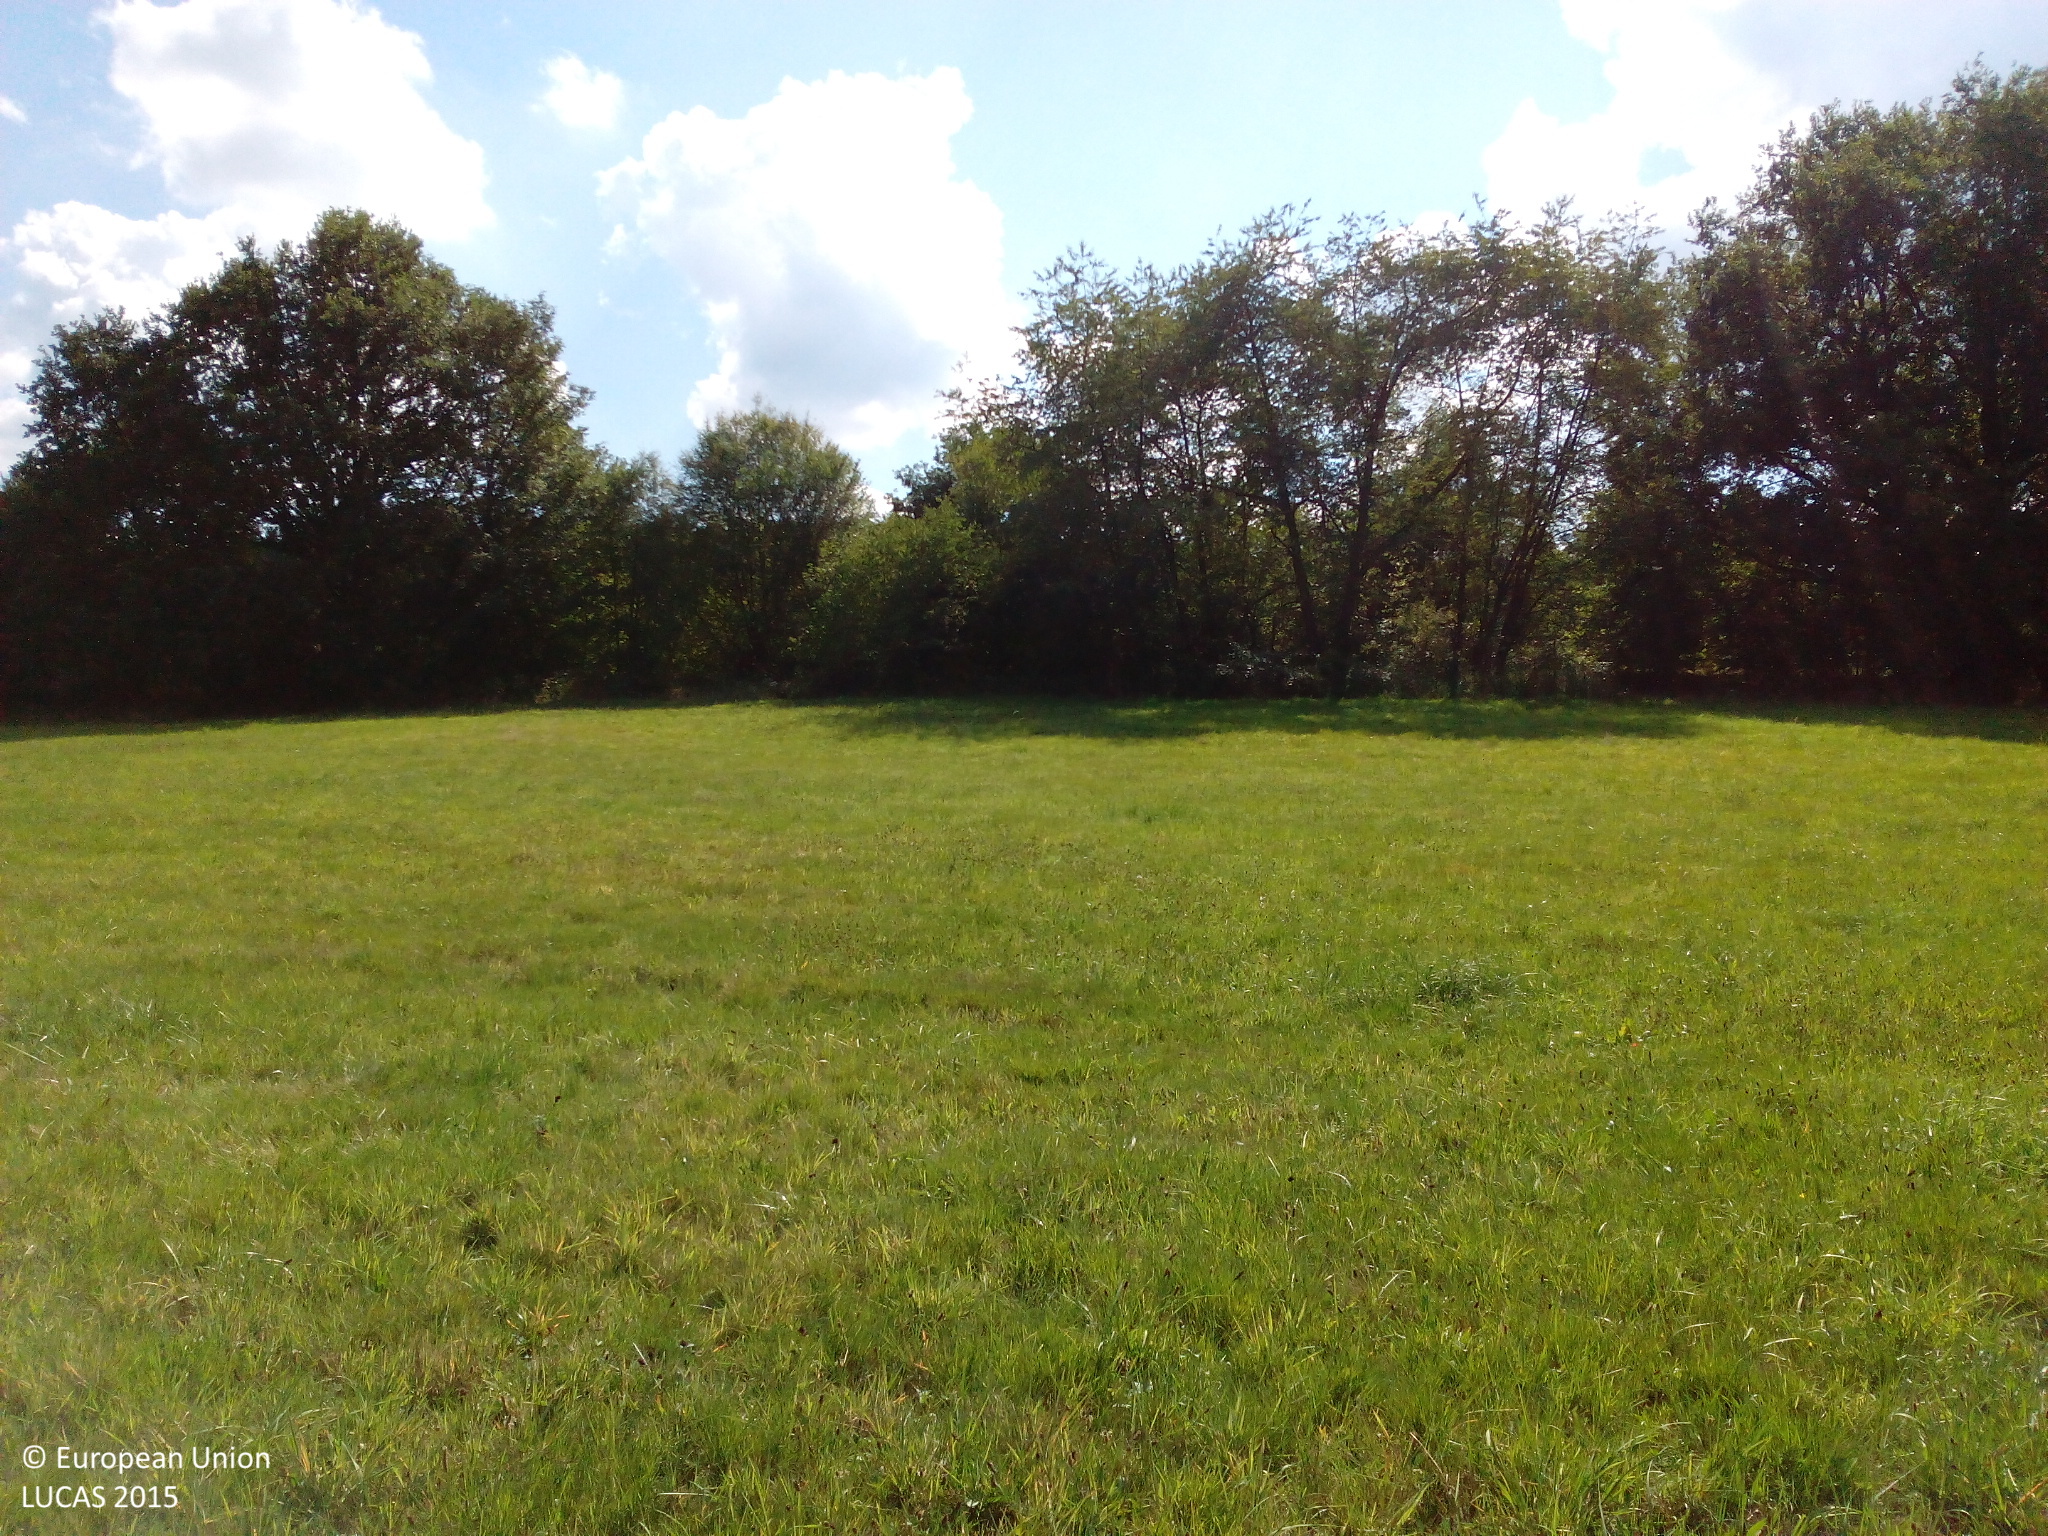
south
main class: Grassland
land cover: Grassland without tree/shrub cover
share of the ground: > 75 %
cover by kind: herbaceous plants 95 %, unconsolidated bare surface 5 %
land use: Agriculture (excluding fallow land and kitchen gardens)
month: September
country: DE
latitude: 49.9834
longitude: 9.1774
